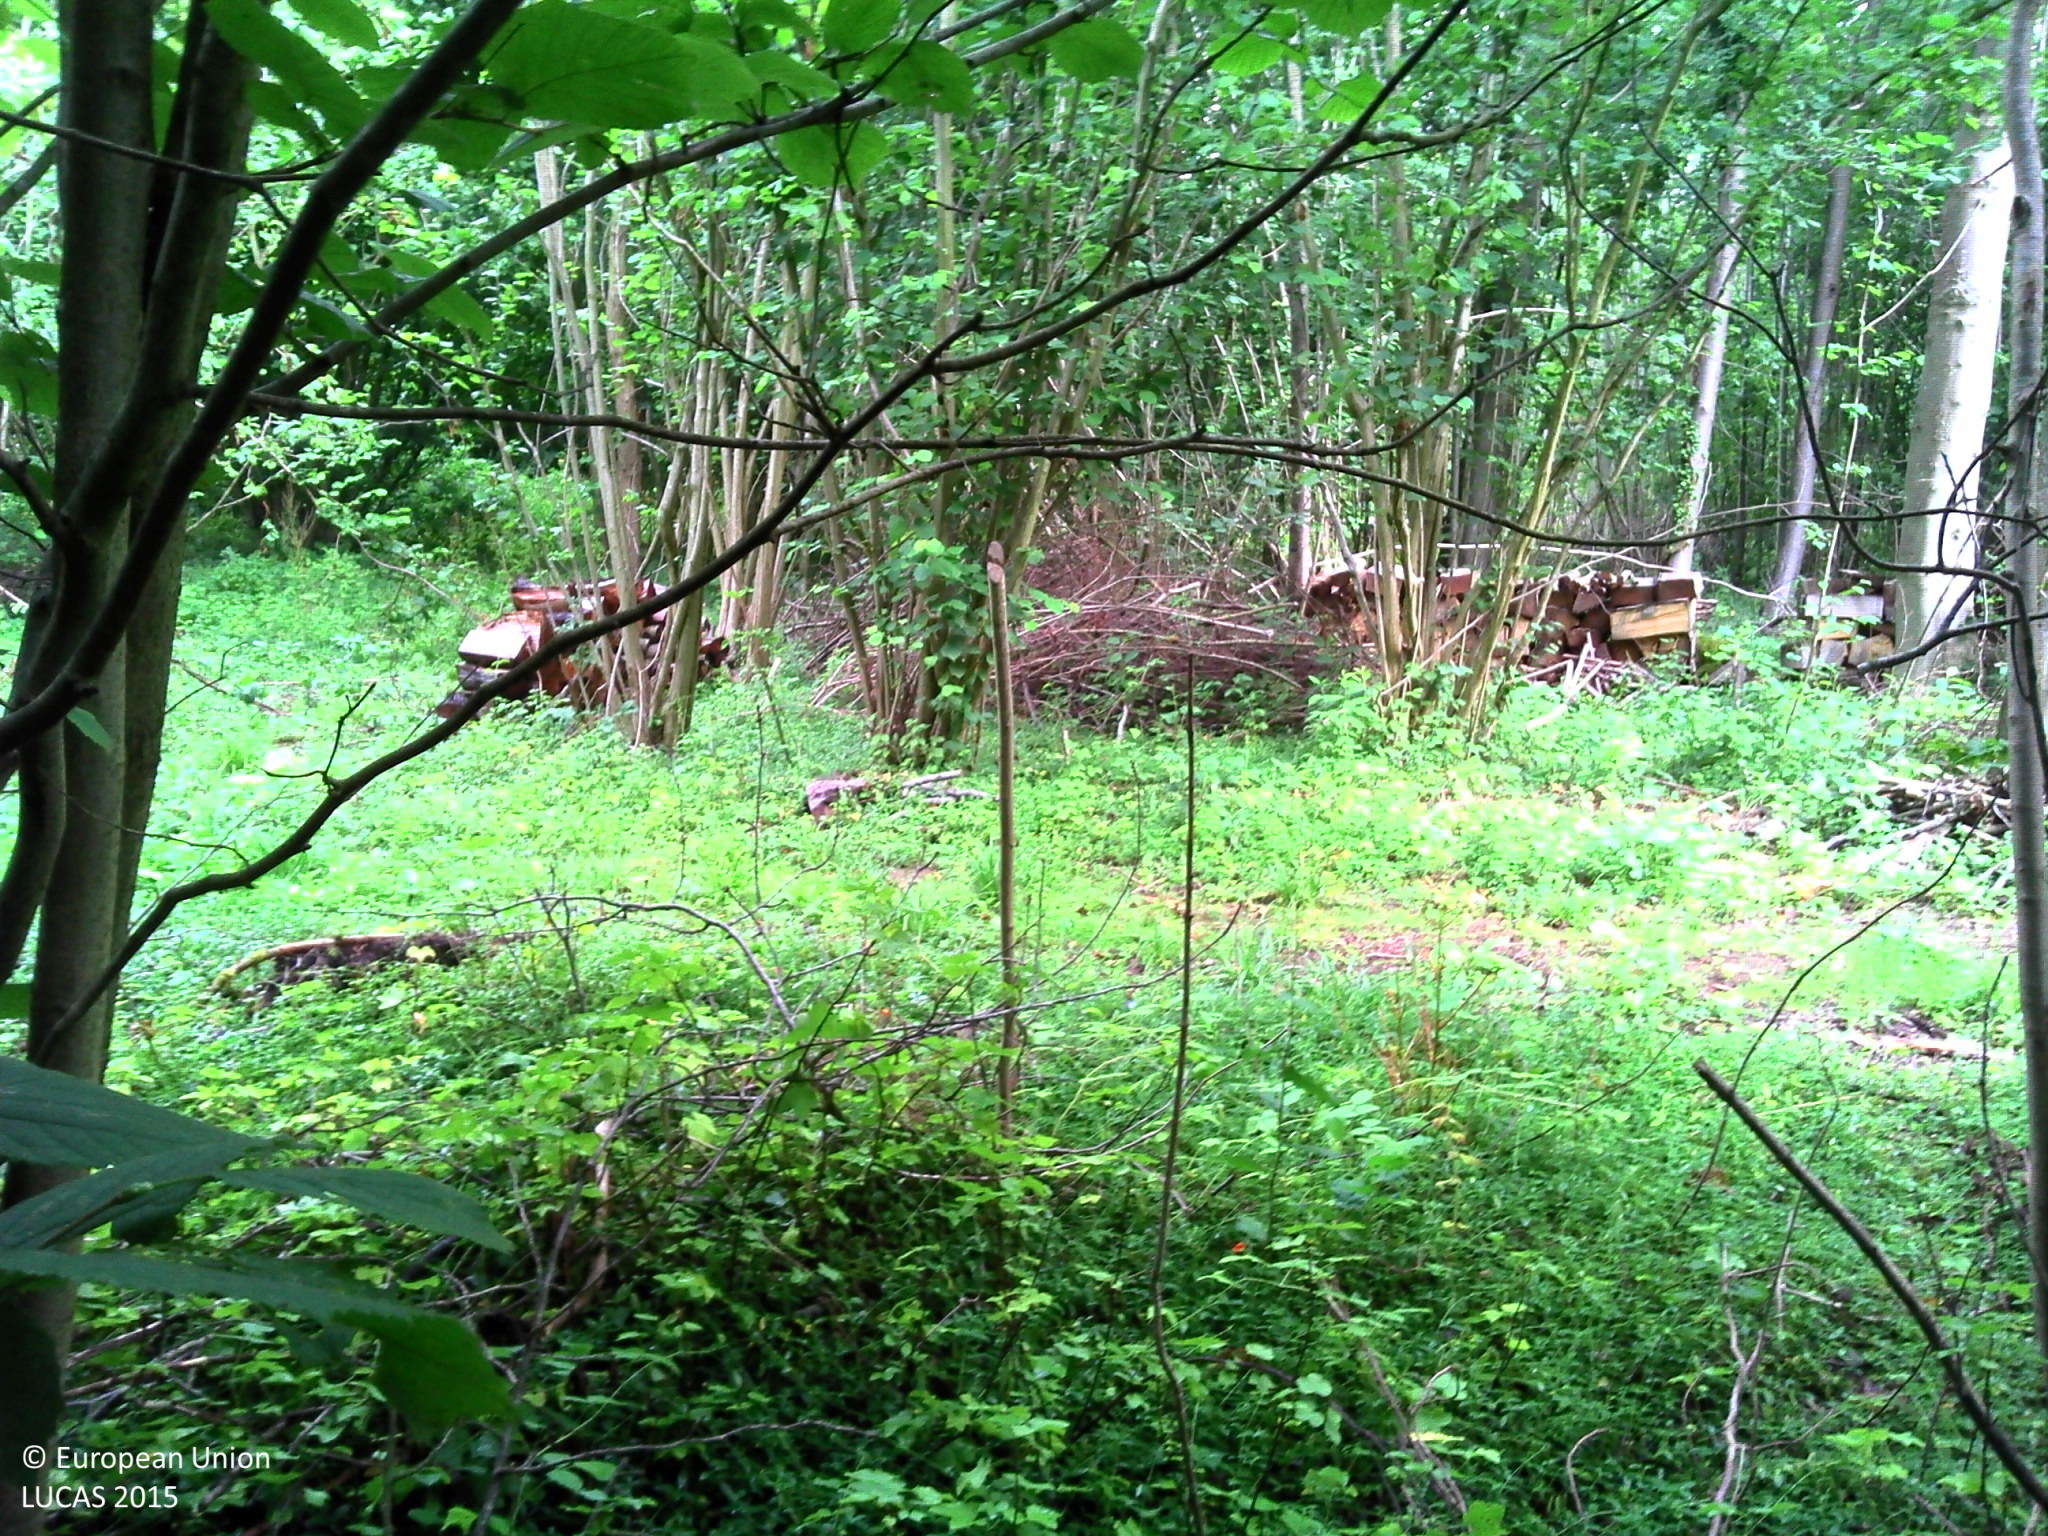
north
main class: Woodland
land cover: Broadleaved woodland
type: mesophytic deciduous forest
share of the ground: > 75 %
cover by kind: broadleaved forest trees 80 %, herbaceous plants 20 %
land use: Forestry
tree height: > 5 m
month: July
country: FR
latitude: 50.8278
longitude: 2.0483
